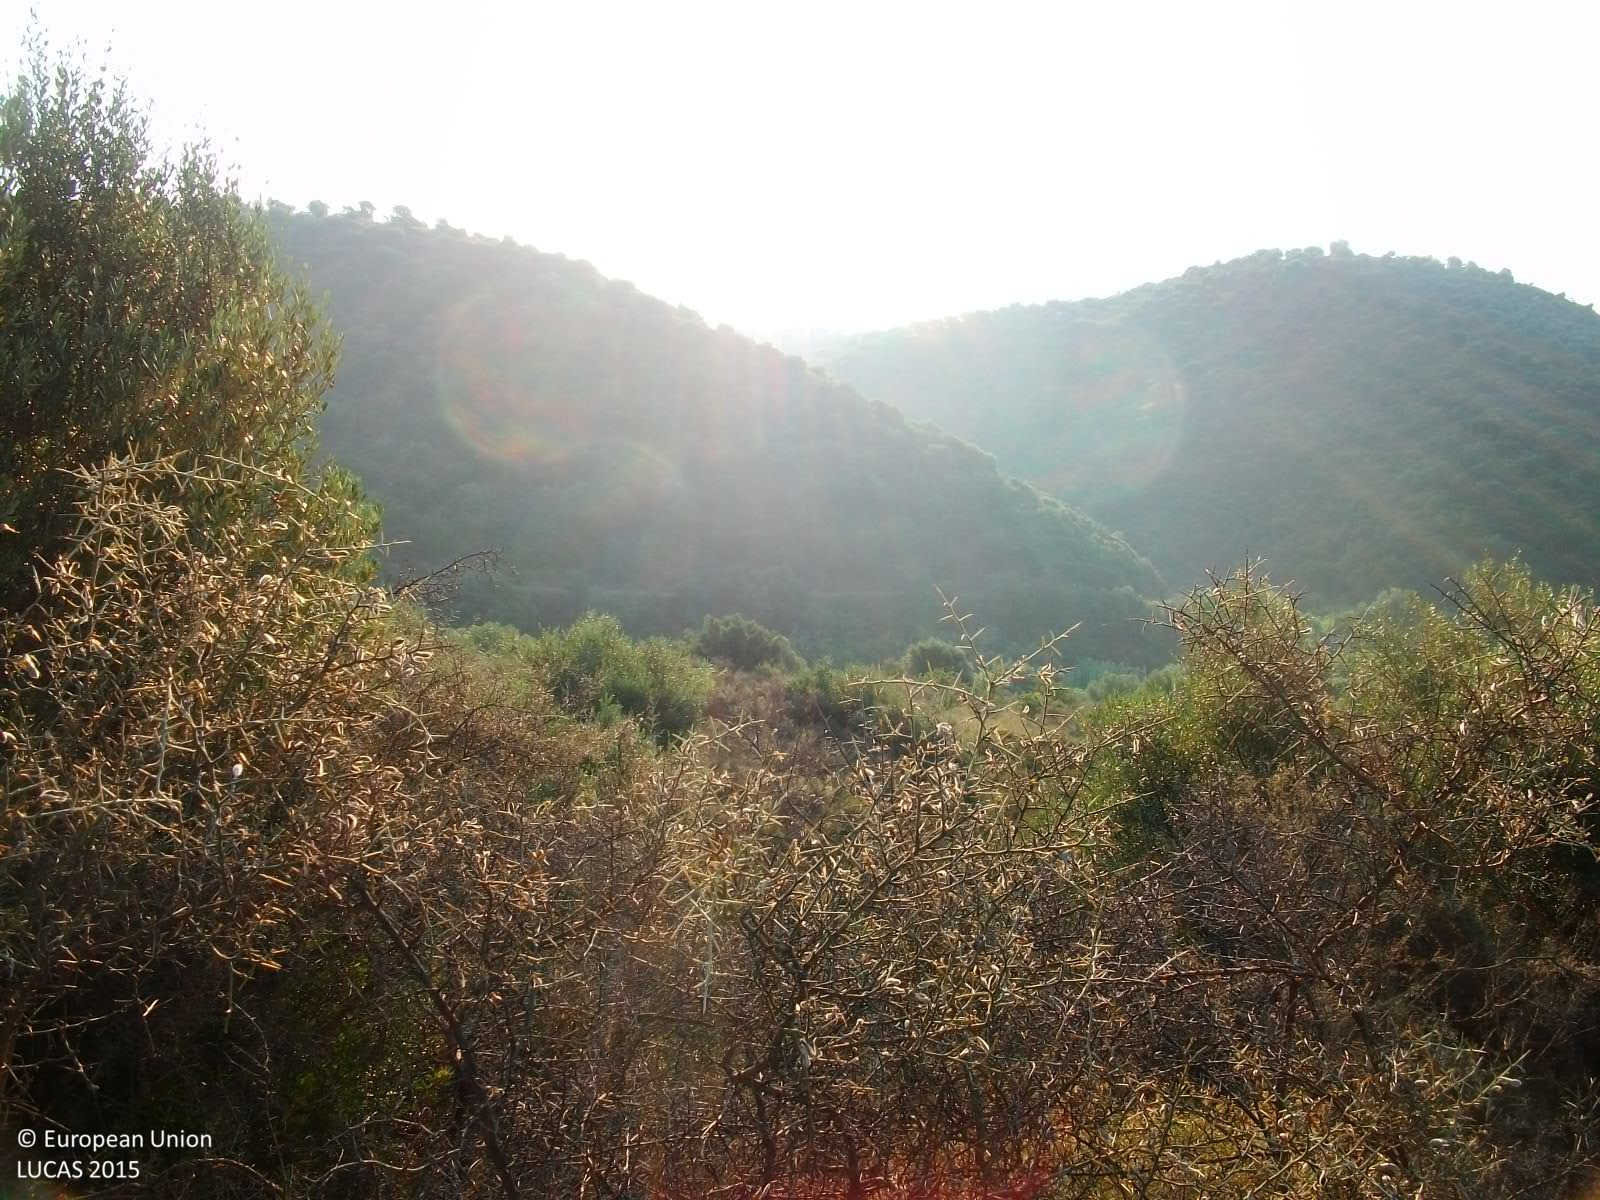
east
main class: Shrubland
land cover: Shrubland without tree cover
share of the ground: > 75 %
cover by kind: shrubs 100 %
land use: Semi-natural and natural areas not in use
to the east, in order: Shrubland without tree cover; Rivers and streams; Shrubland without tree cover; Olive groves; Shrubland without tree cover; Inland marshes; Inland fresh running water; Shrubland without tree cover; Grass margins; Tracks; Grass margins
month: July
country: GR
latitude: 37.1715
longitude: 21.9716
